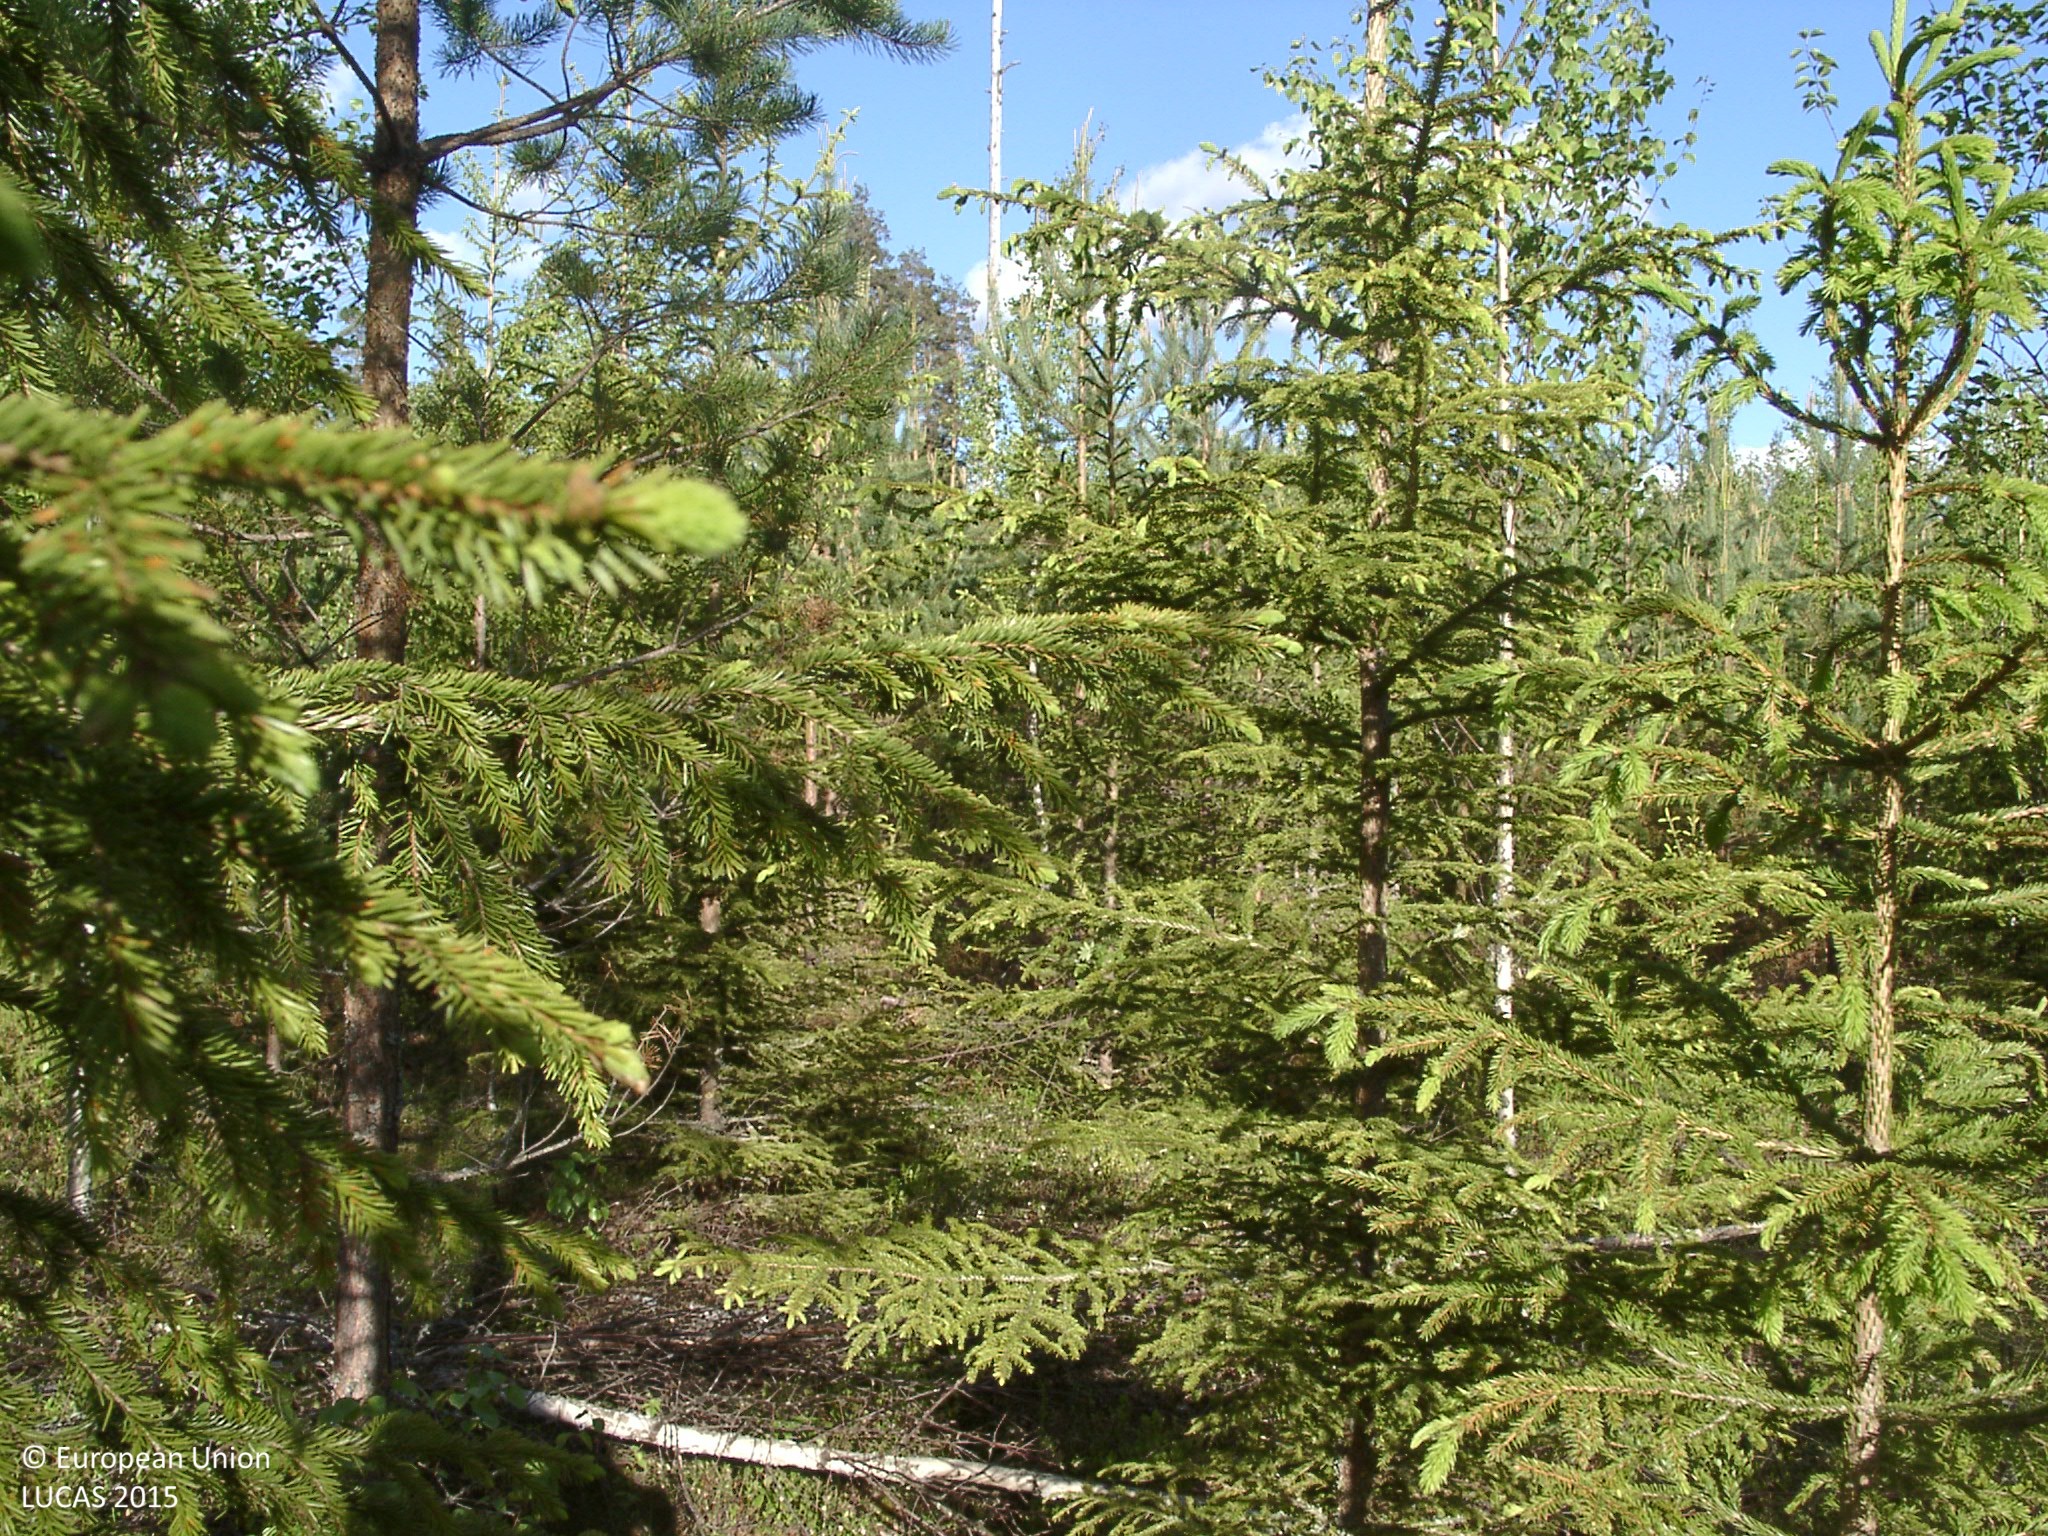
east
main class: Woodland
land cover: Other mixed woodland
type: boreal forest
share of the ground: 25 - 50 %
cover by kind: coniferous forest trees 30 %, shrubs 25 %, broadleaved forest trees 10 %, lichens and mosses 10 %, herbaceous plants 5 %
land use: Forestry
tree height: < 5 m
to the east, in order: Other mixed woodland; Other coniferous woodland; Groves; Shruby margins; Ditches and canals; Paved roads, cycling and walking lanes; Ditches and canals; Shruby margins; Groves; Grassland with sparse tree/shrub cover; Spruce dominated mixed woodland; Electric lines; Spruce dominated mixed woodland; Ditches and canals; Other coniferous woodland; Ditches and canals; Spruce dominated coniferous woodland
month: June
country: FI
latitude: 61.7371
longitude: 24.8899
